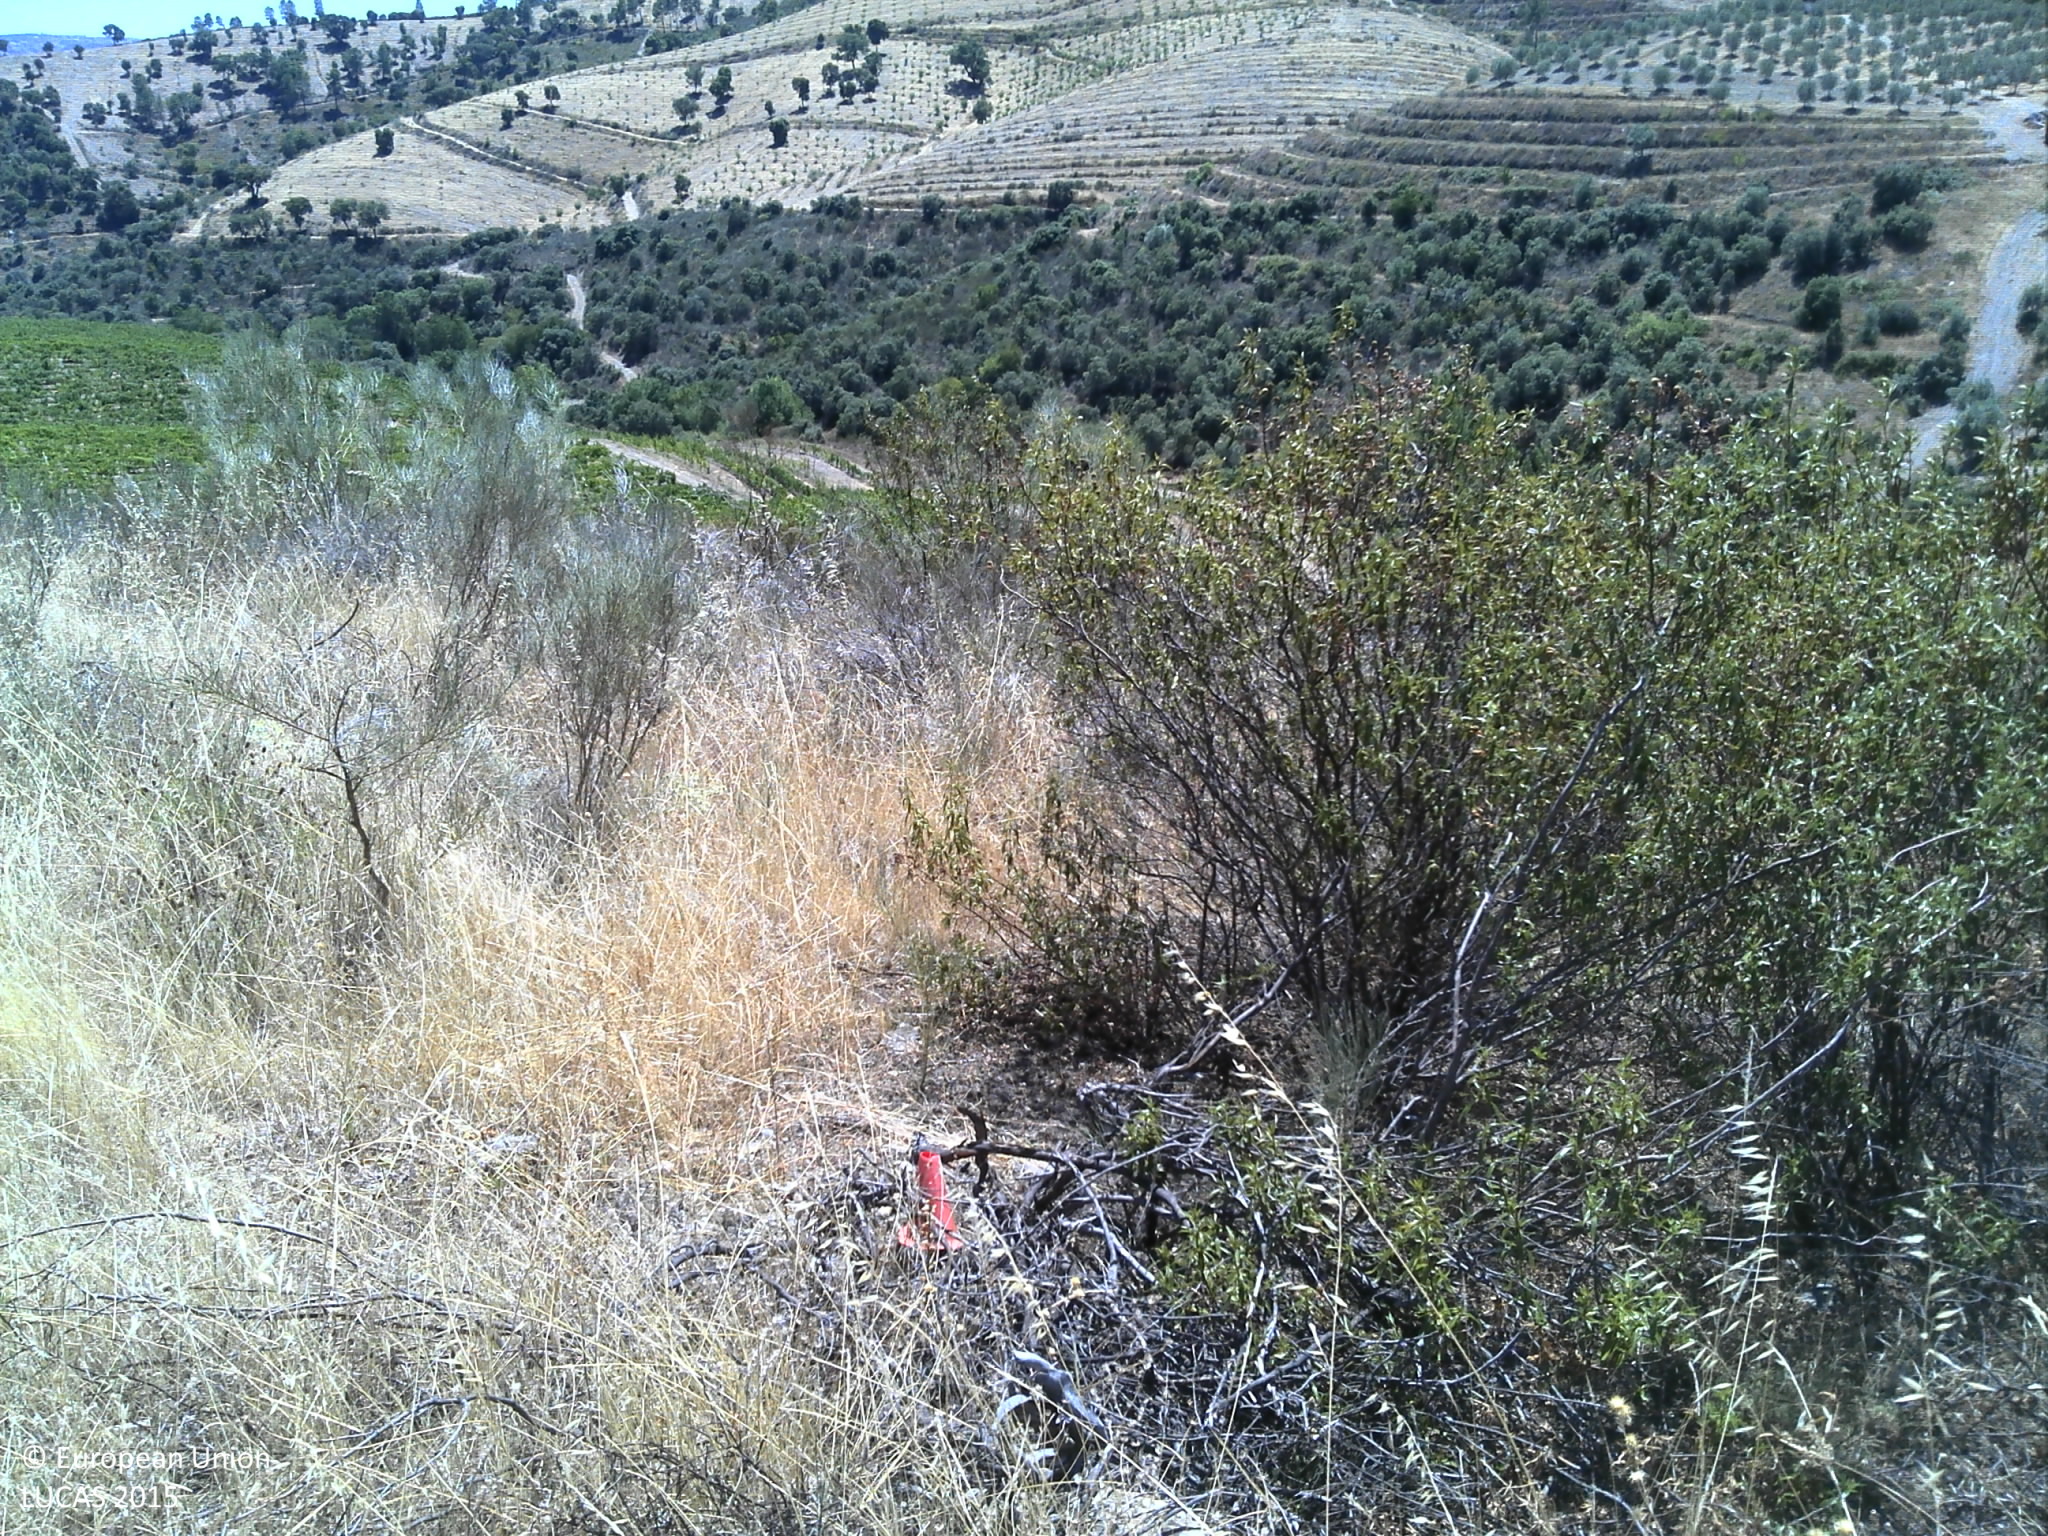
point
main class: Shrubland
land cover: Shrubland without tree cover
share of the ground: > 75 %
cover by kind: shrubs 80 %, herbaceous plants 20 %
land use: Abandoned areas
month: July
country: PT
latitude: 41.3138
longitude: -7.1127
